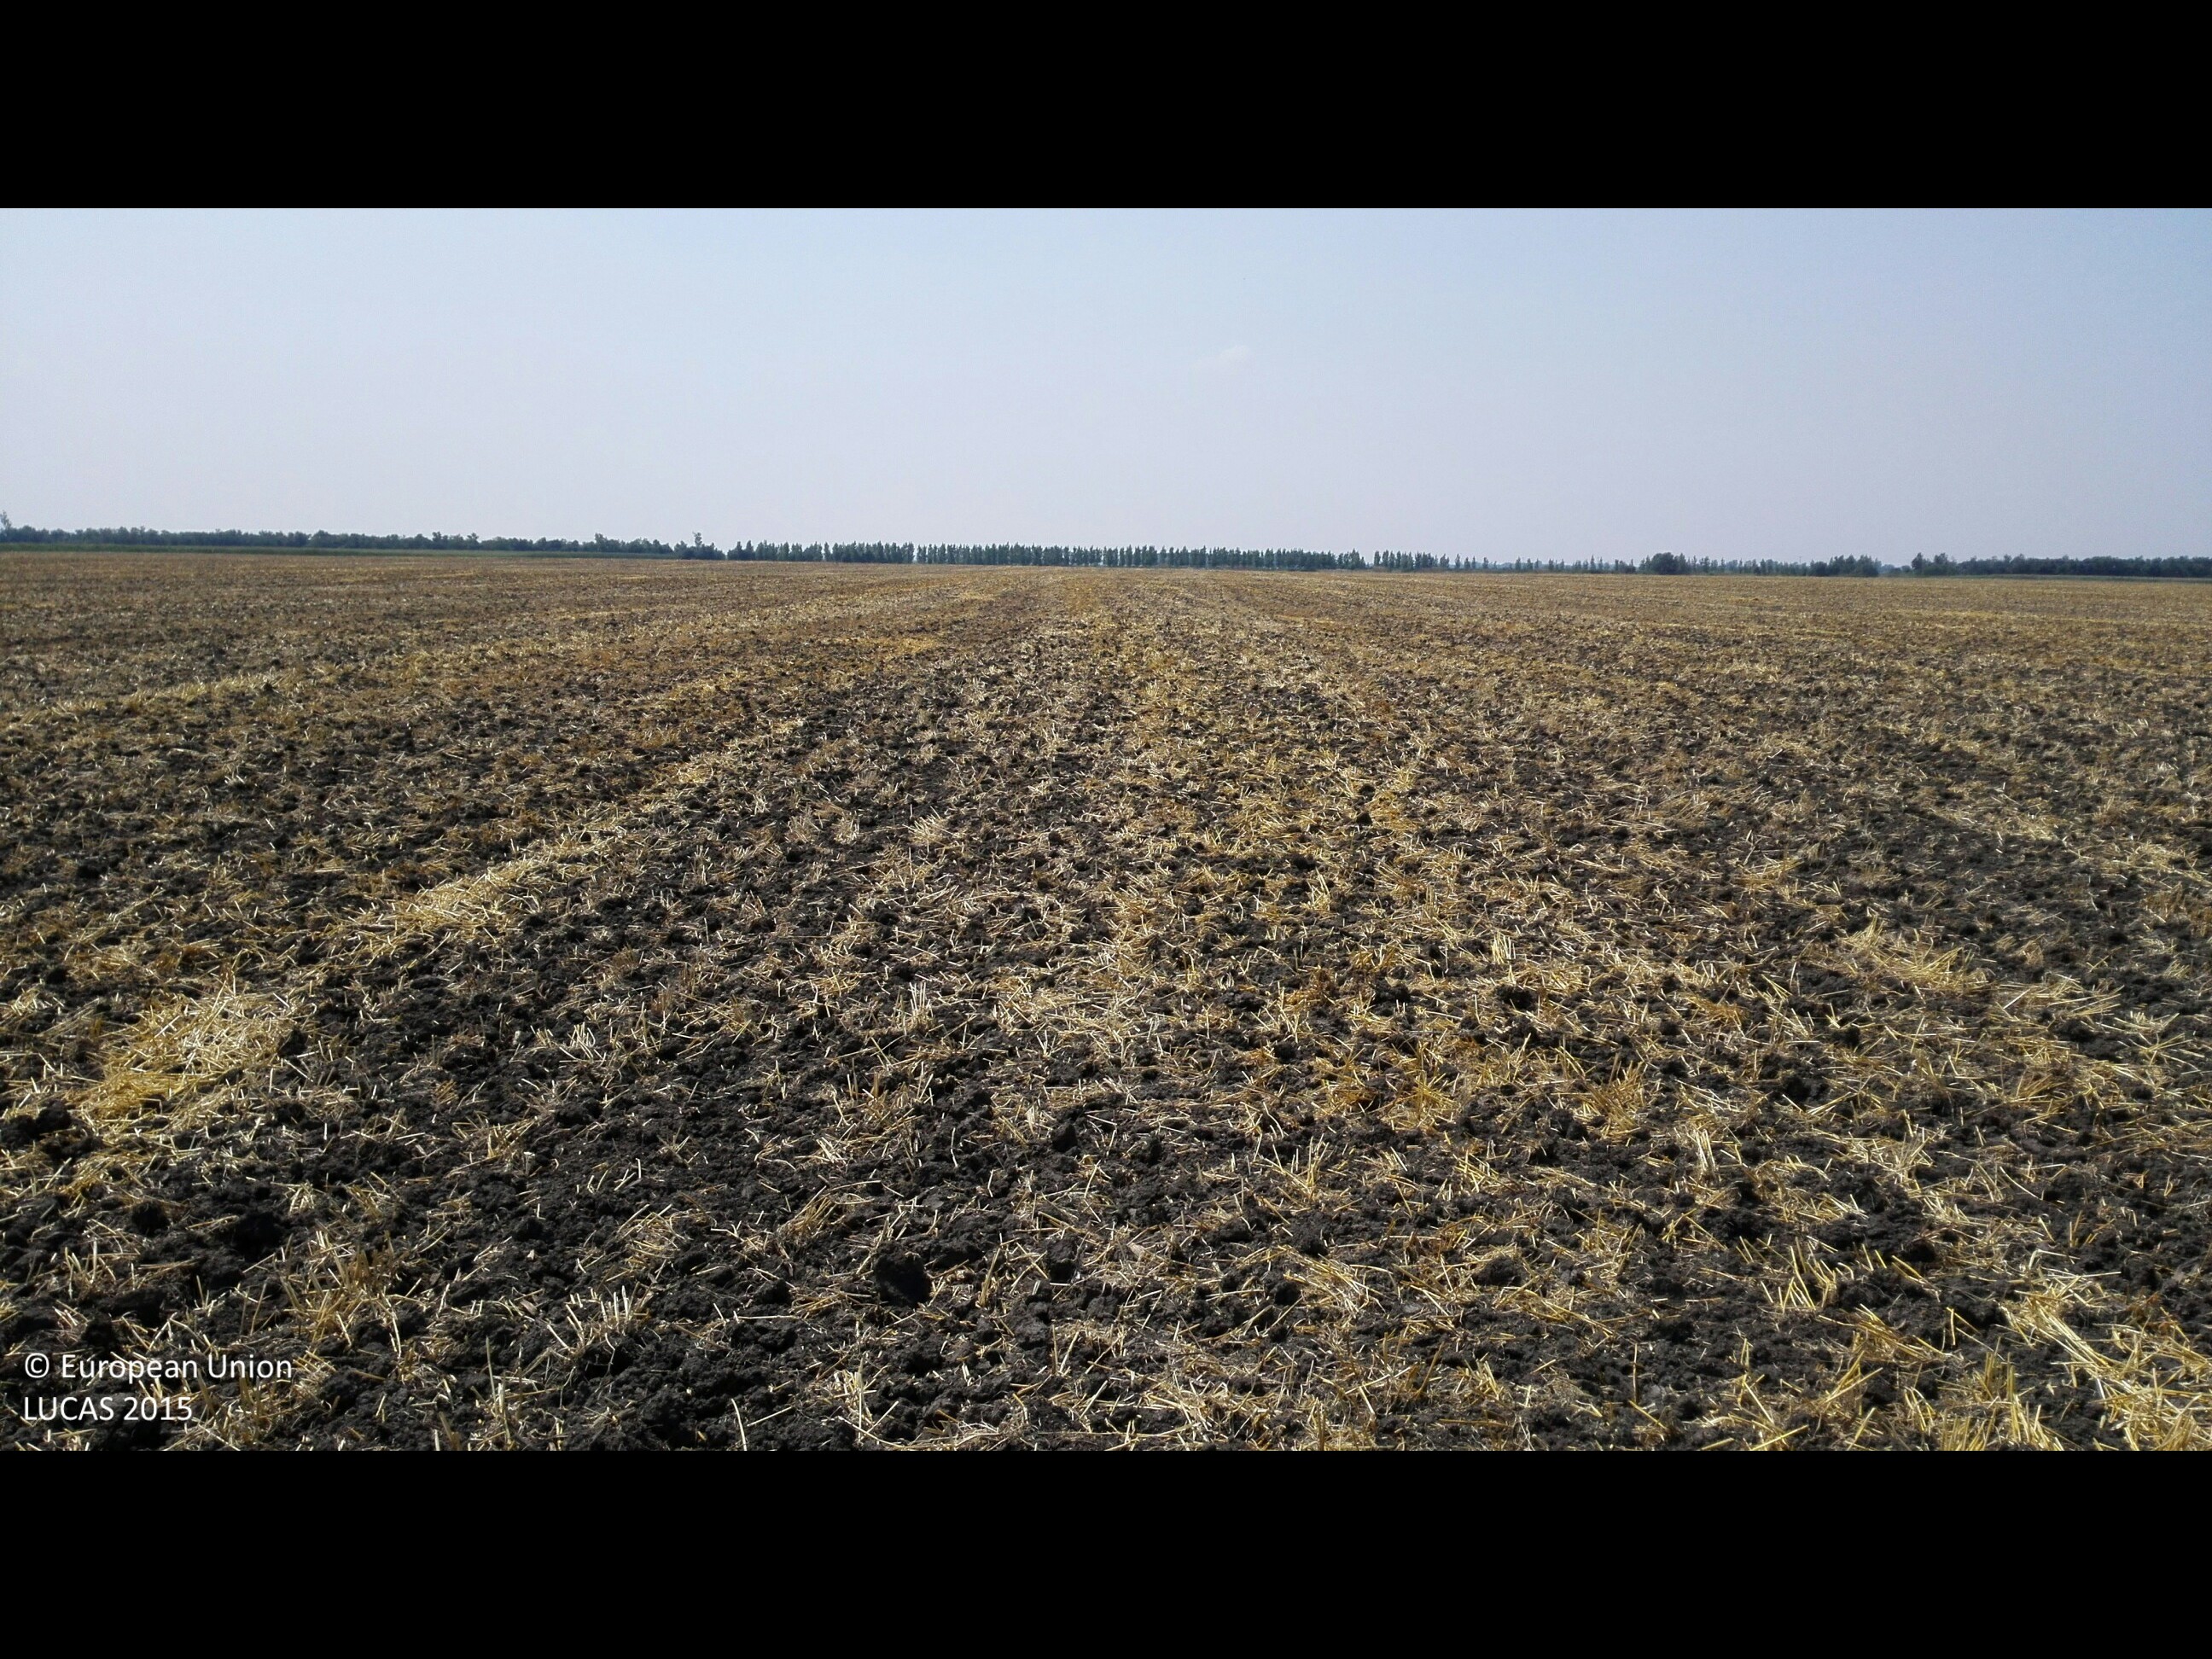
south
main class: Cropland
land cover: Common wheat
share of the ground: > 75 %
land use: Agriculture (excluding fallow land and kitchen gardens)
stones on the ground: < 10 %
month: July
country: HU
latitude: 47.1921
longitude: 21.2436
